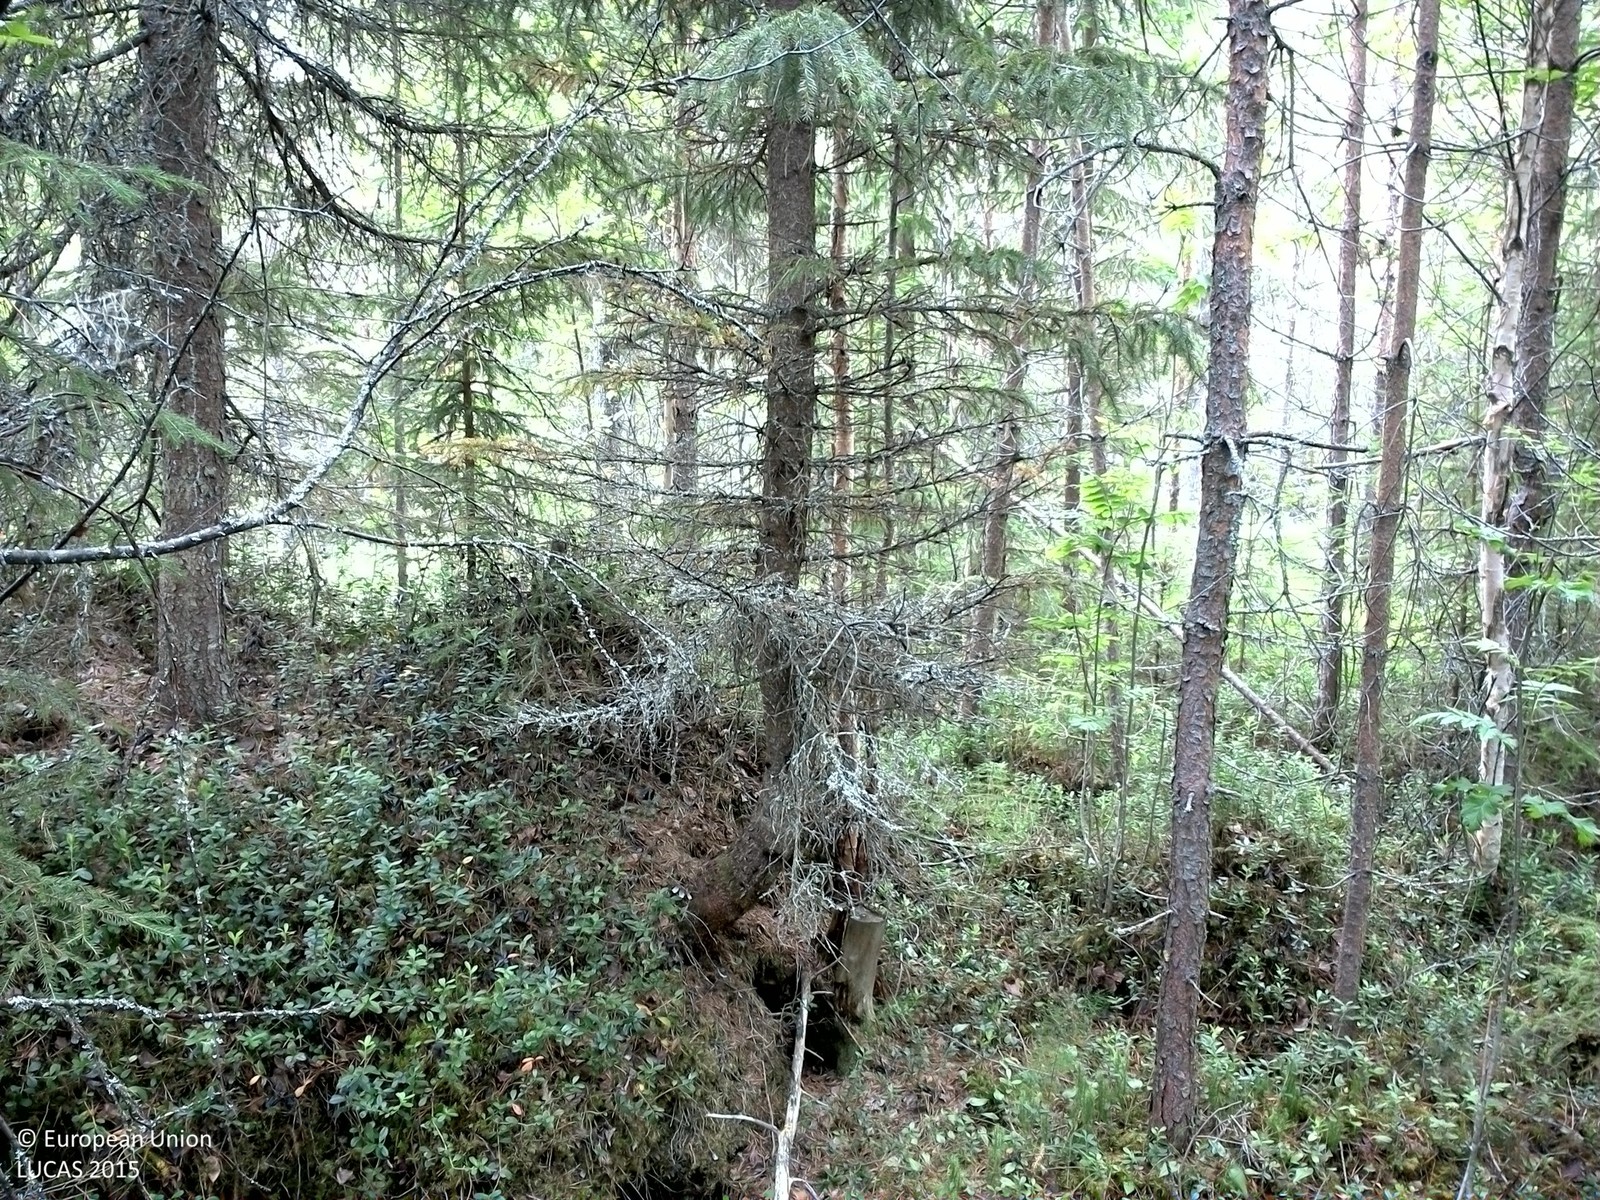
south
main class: Woodland
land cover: Pine dominated mixed woodland
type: boreal forest
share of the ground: > 75 %
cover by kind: coniferous forest trees 45 %, broadleaved forest trees 40 %, shrubs 5 %, herbaceous plants 5 %, lichens and mosses 5 %
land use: Forestry
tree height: > 5 m
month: August
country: SE
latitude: 63.6637
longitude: 16.5793
